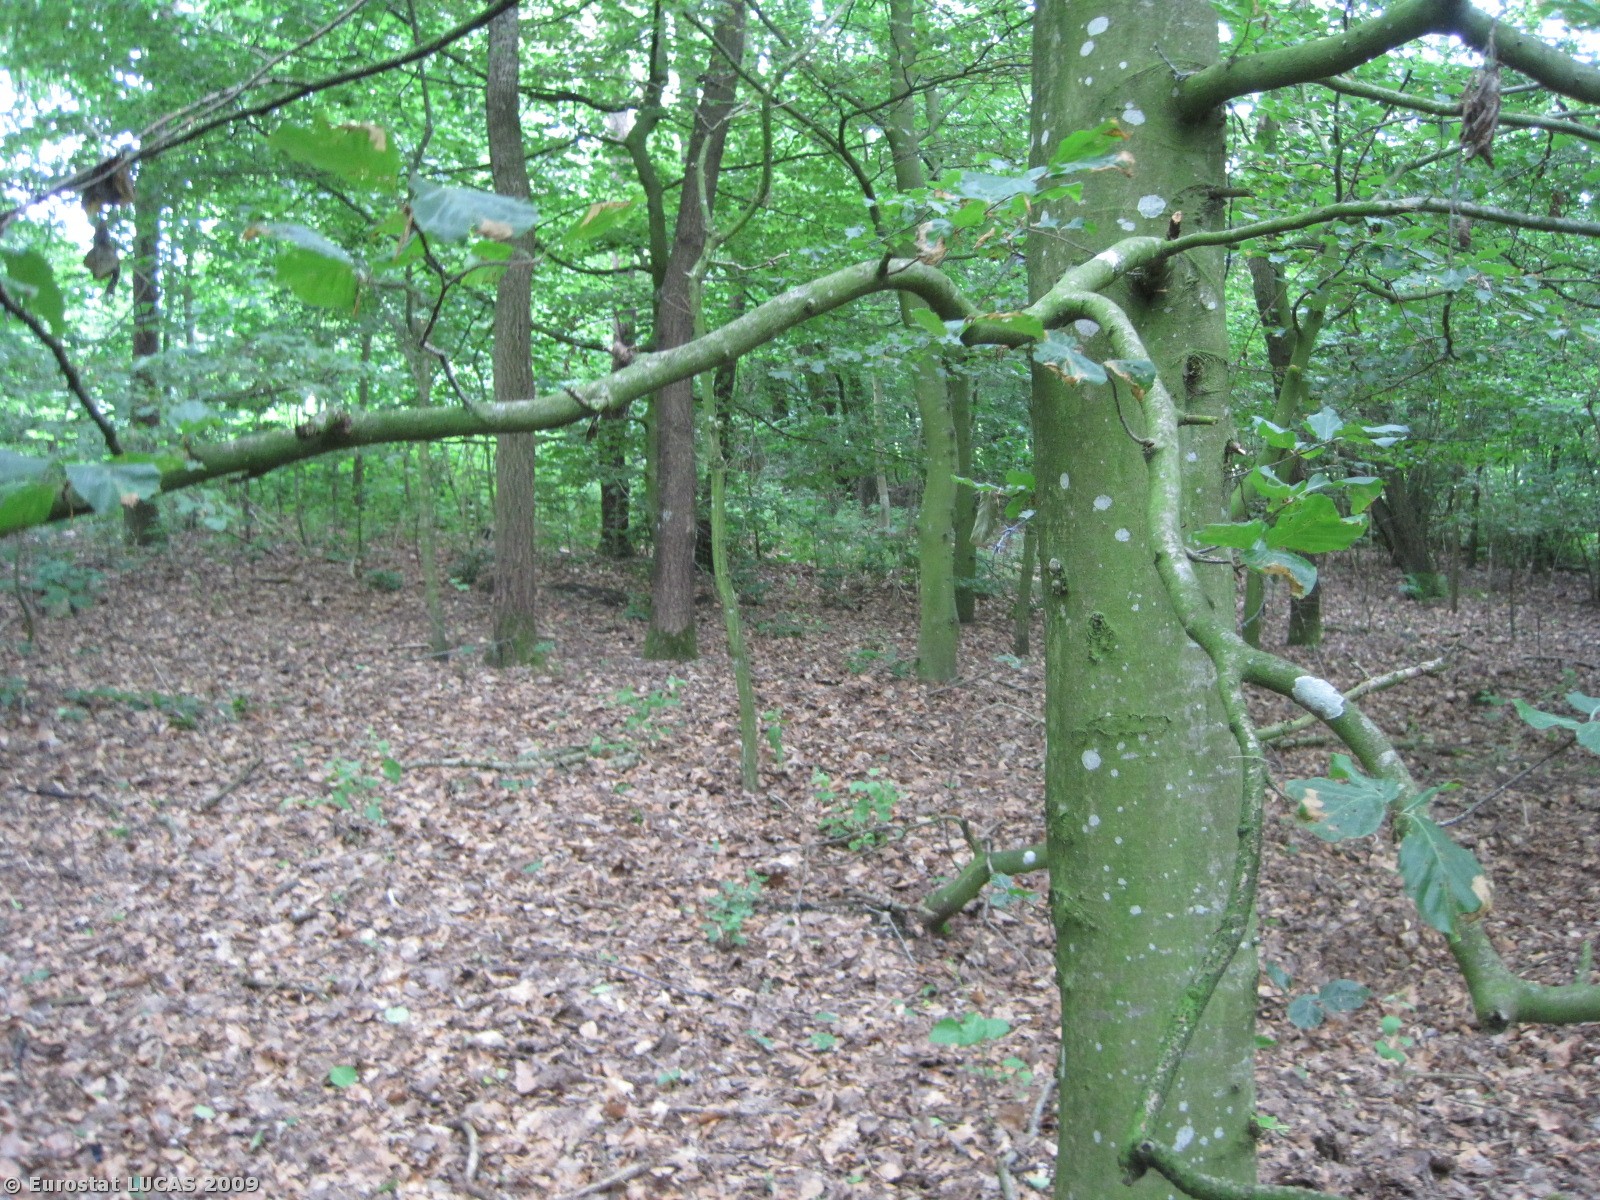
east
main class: Woodland
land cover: Broadleaved woodland
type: plantations and self-sown exotic forest
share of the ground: > 75 %
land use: Unused
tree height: > 5 m
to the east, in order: Broadleaved woodland; Grassland without tree/shrub cover; Artificial constructions in urban areas; Grassland without tree/shrub cover; Broadleaved woodland; Grass margins; Maize; Grass margins; Tracks
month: June
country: DK
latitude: 57.2124
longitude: 10.0496
